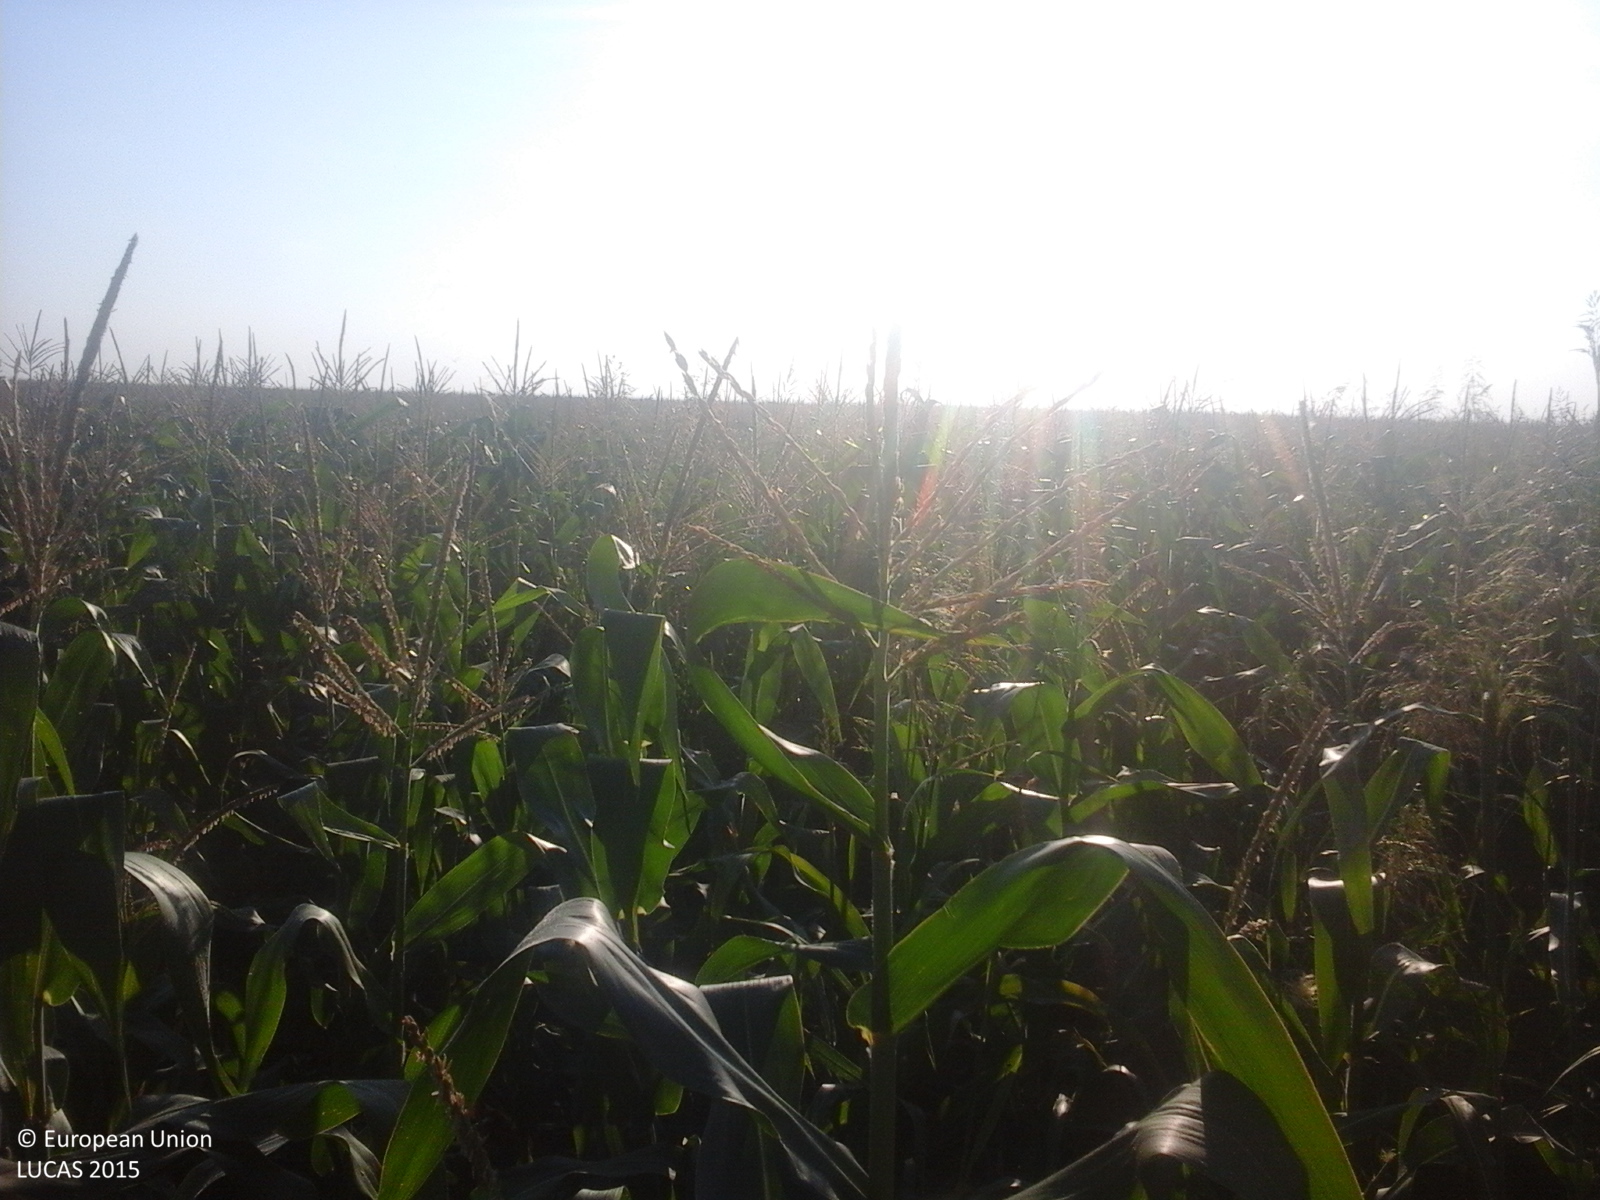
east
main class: Cropland
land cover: Maize
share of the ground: > 75 %
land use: Agriculture (excluding fallow land and kitchen gardens)
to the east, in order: Maize
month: July
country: RO
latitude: 44.3933
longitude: 27.1940
